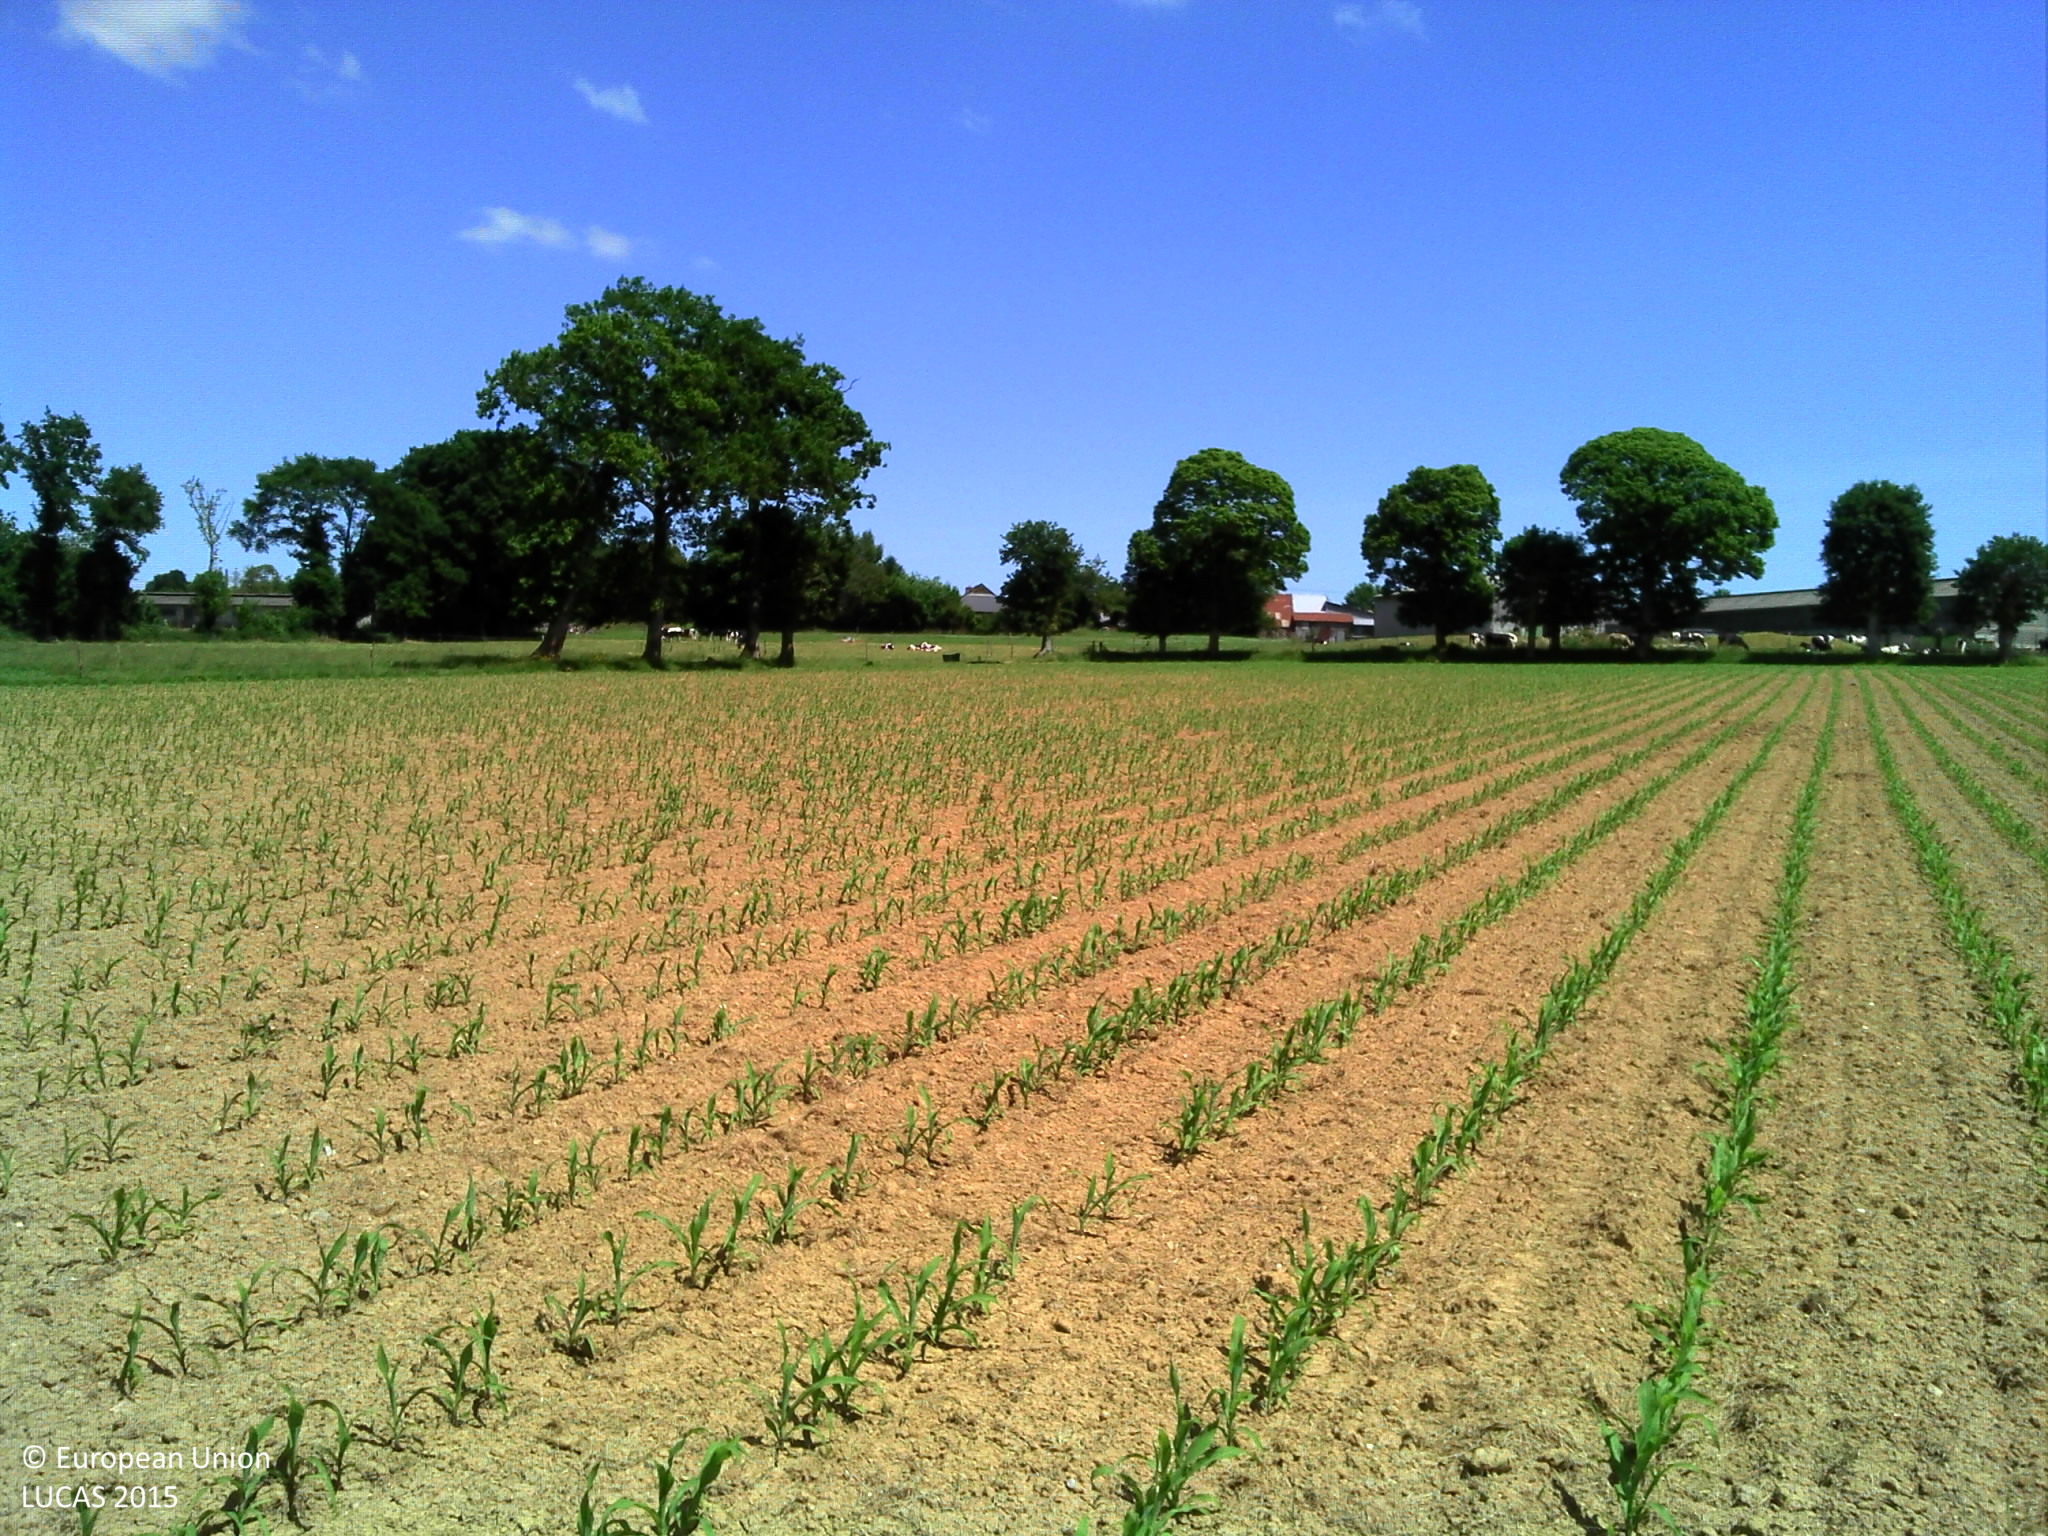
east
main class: Cropland
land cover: Maize
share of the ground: > 75 %
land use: Agriculture (excluding fallow land and kitchen gardens)
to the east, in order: Maize; Lines of trees; Fences; Tracks; Fences; Grassland without tree/shrub cover; Fences; Grassland without tree/shrub cover; Fences; Grassland without tree/shrub cover; Fences; Grassland without tree/shrub cover; Broadleaved woodland
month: June
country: FR
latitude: 48.1305
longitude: -1.4798
